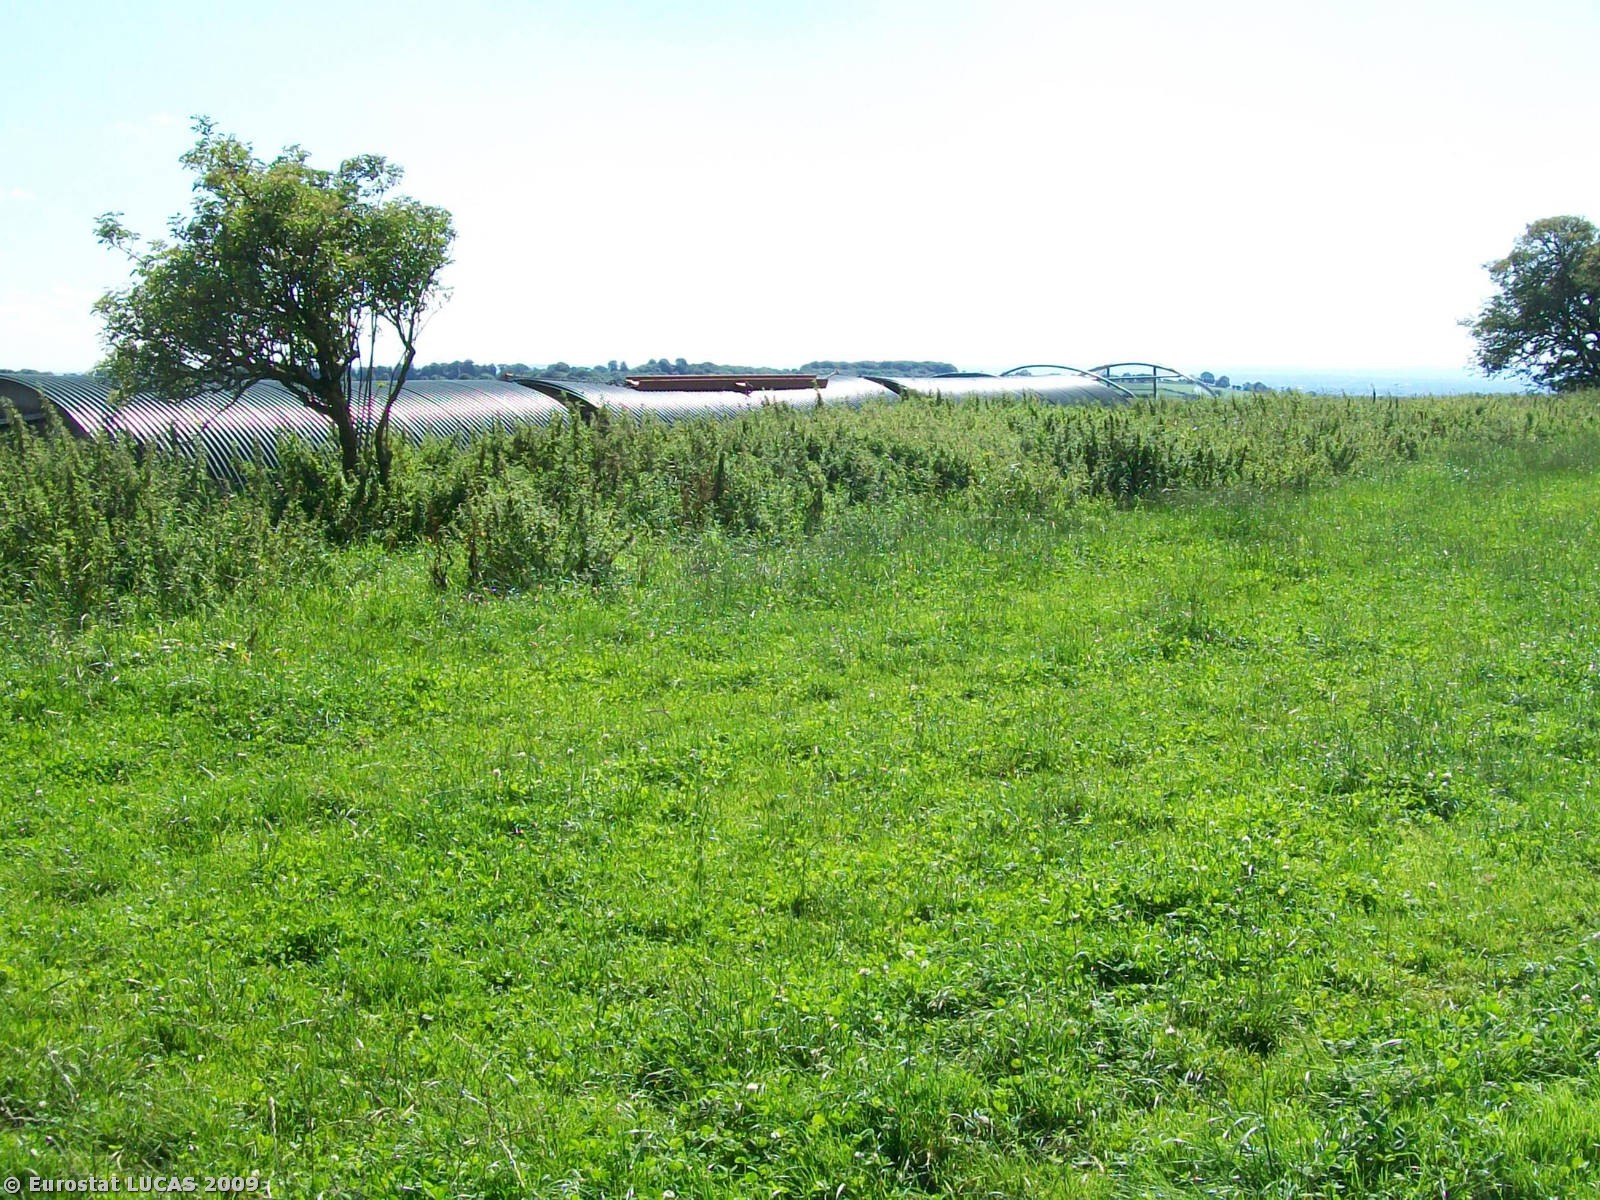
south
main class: Grassland
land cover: Grassland without tree/shrub cover
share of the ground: > 75 %
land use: Agriculture (excluding fallow land and kitchen gardens)
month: August
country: GB
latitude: 51.6612
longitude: -2.3081
